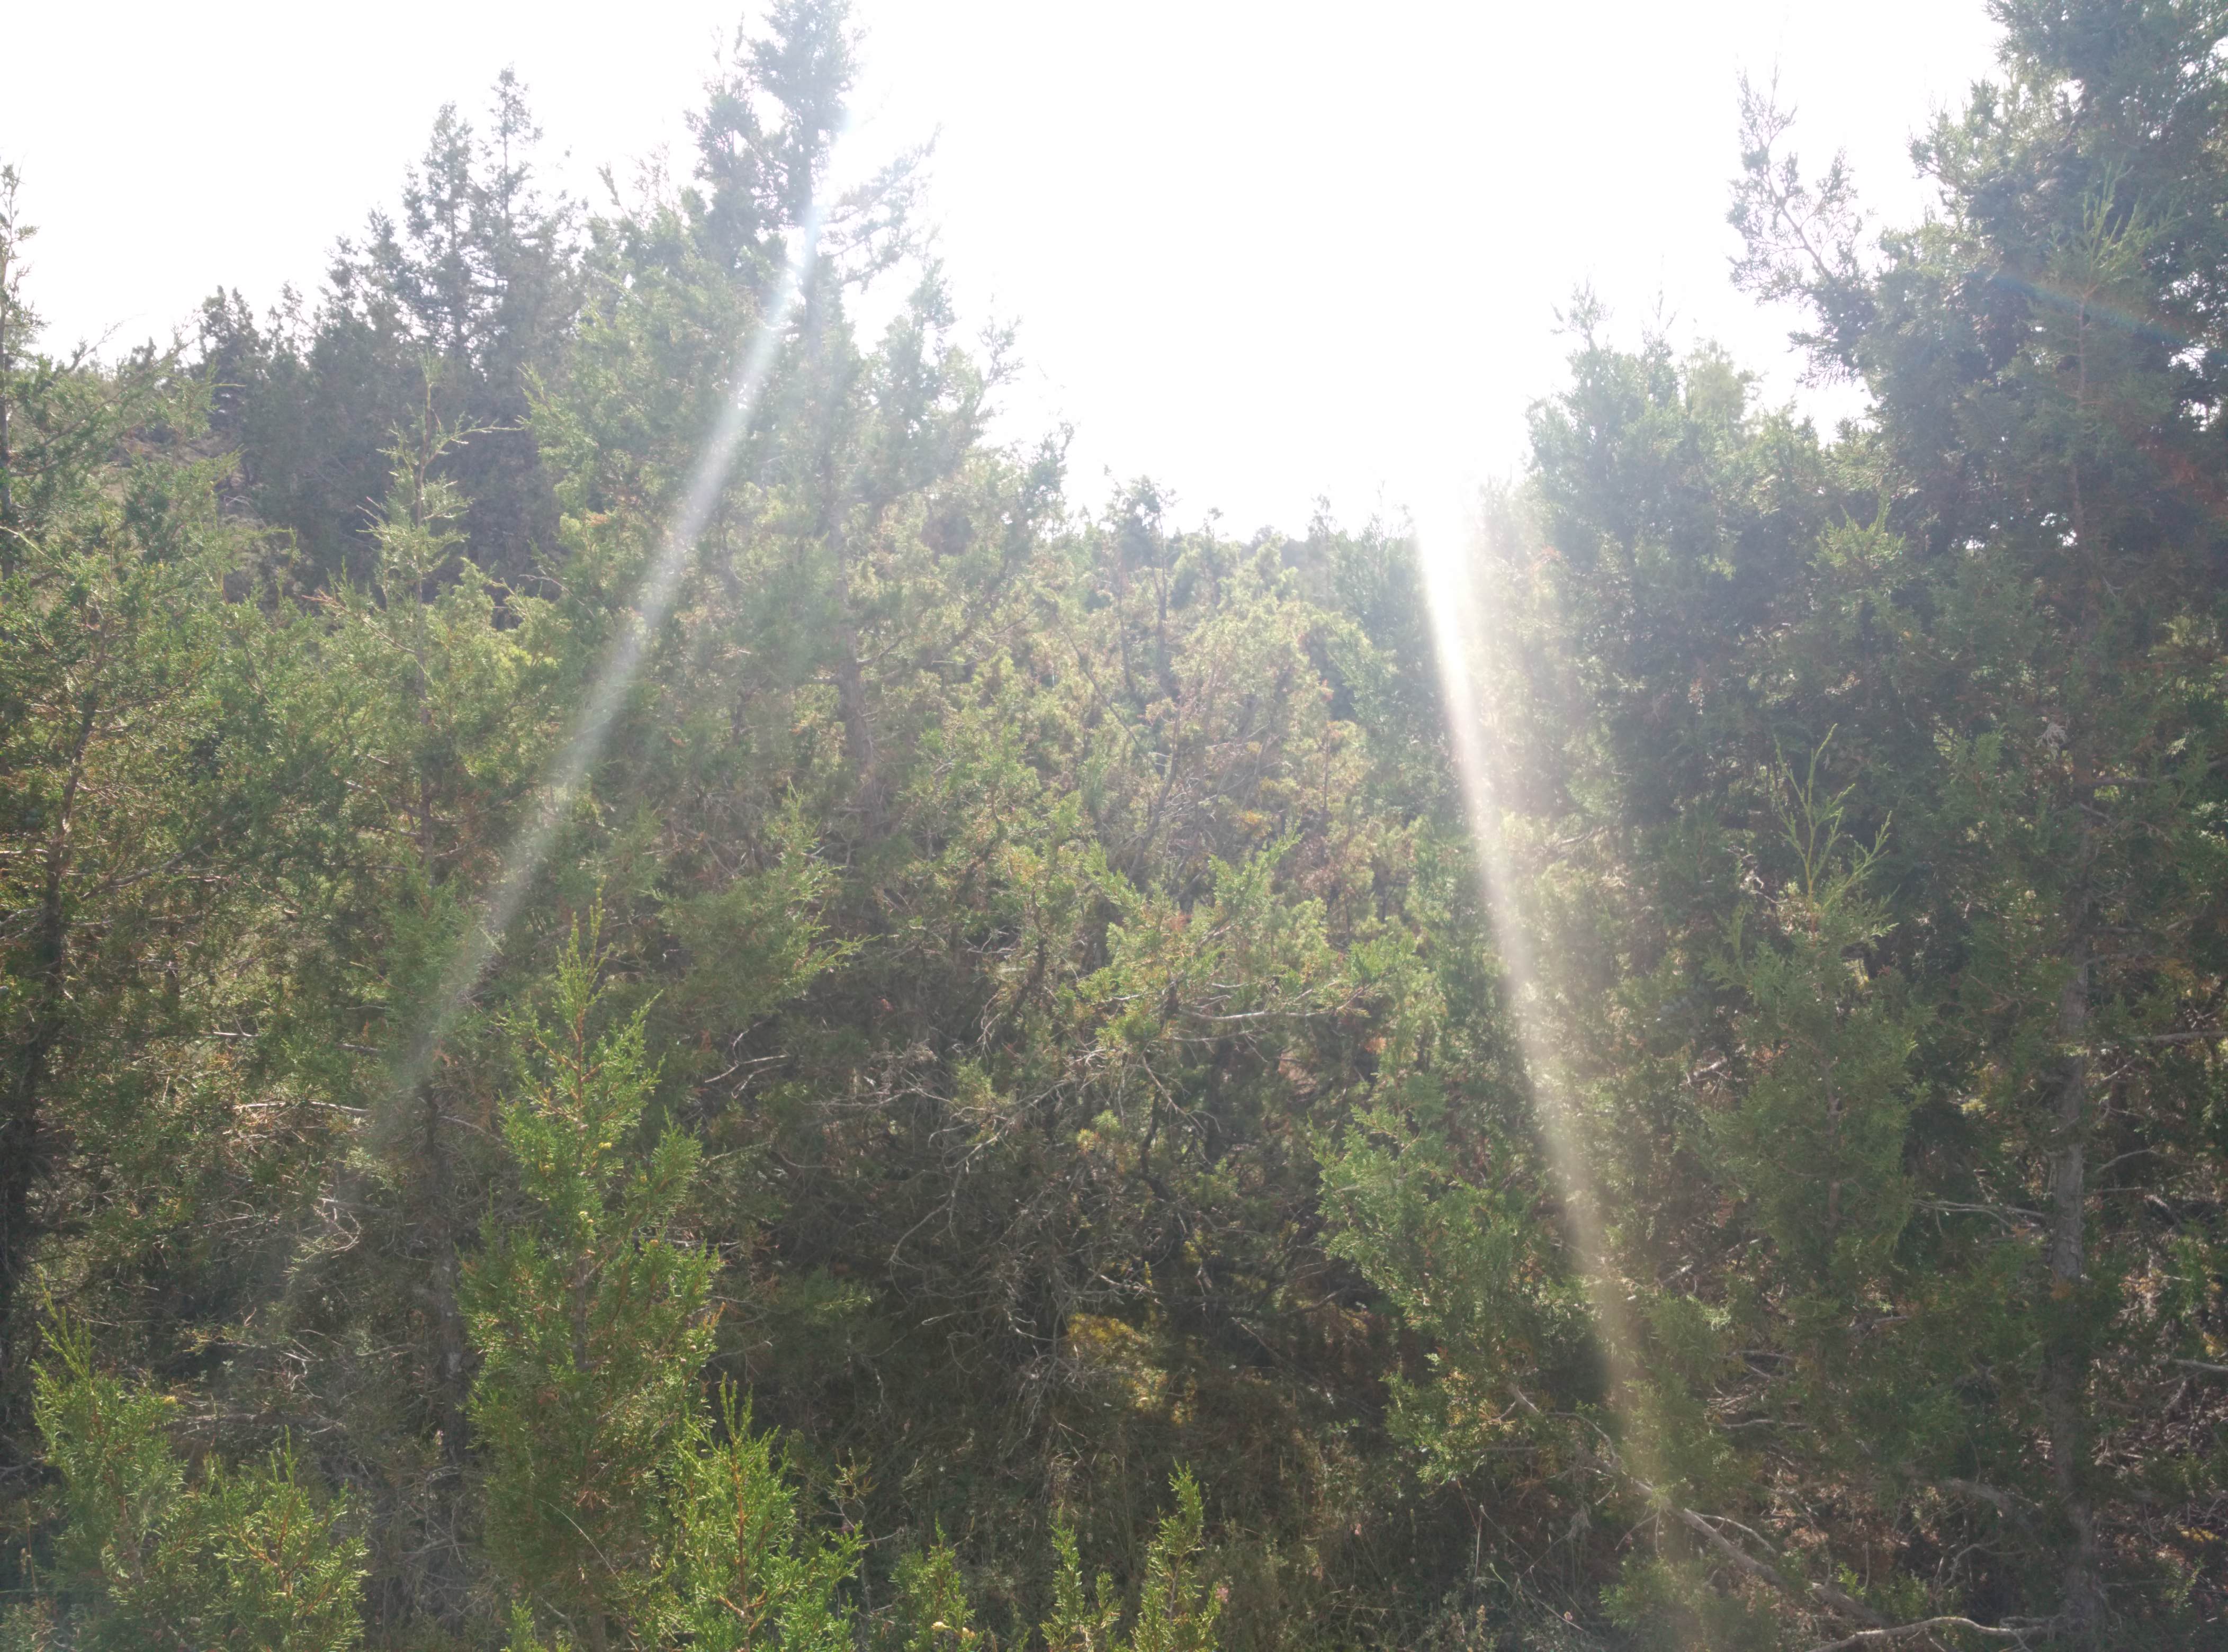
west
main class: Woodland
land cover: Other coniferous woodland
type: coniferous forest of the mediterranean region
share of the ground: 50 - 75 %
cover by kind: coniferous forest trees 50 %, herbaceous plants 25 %, shrubs 20 %, unconsolidated bare surface 5 %
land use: Semi-natural and natural areas not in use
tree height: > 5 m
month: July
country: ES
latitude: 41.0346
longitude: -2.0754
